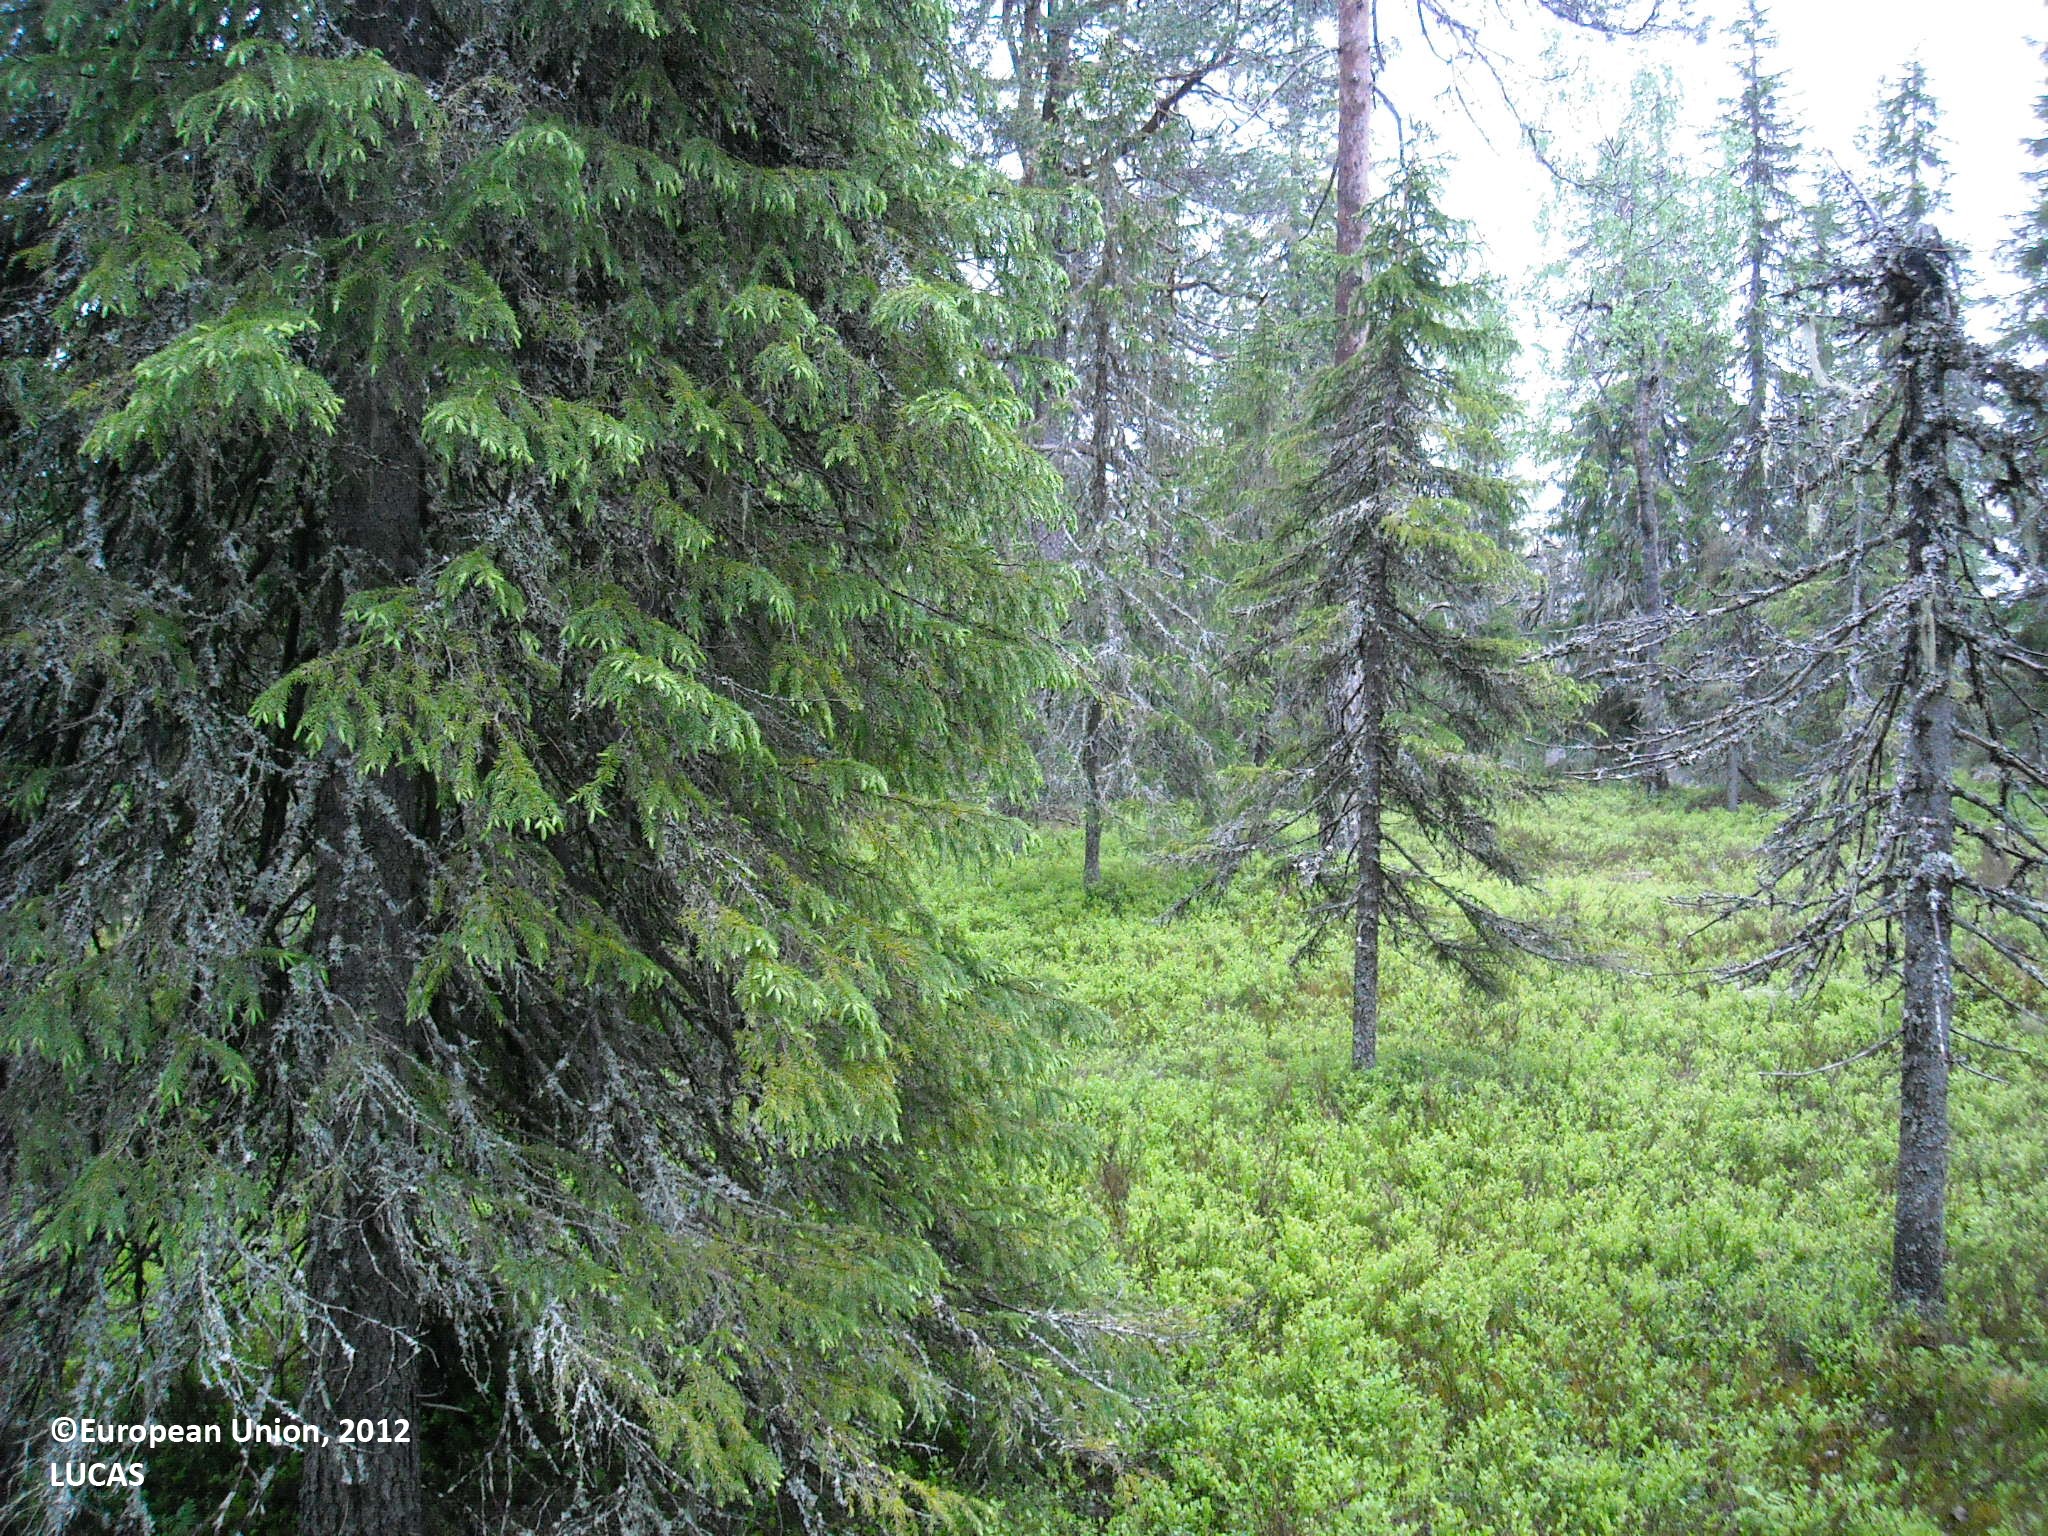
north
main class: Woodland
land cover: Other coniferous woodland
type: boreal forest
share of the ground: > 75 %
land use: Forestry
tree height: > 5 m
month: June
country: FI
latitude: 65.5908
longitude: 27.8569
